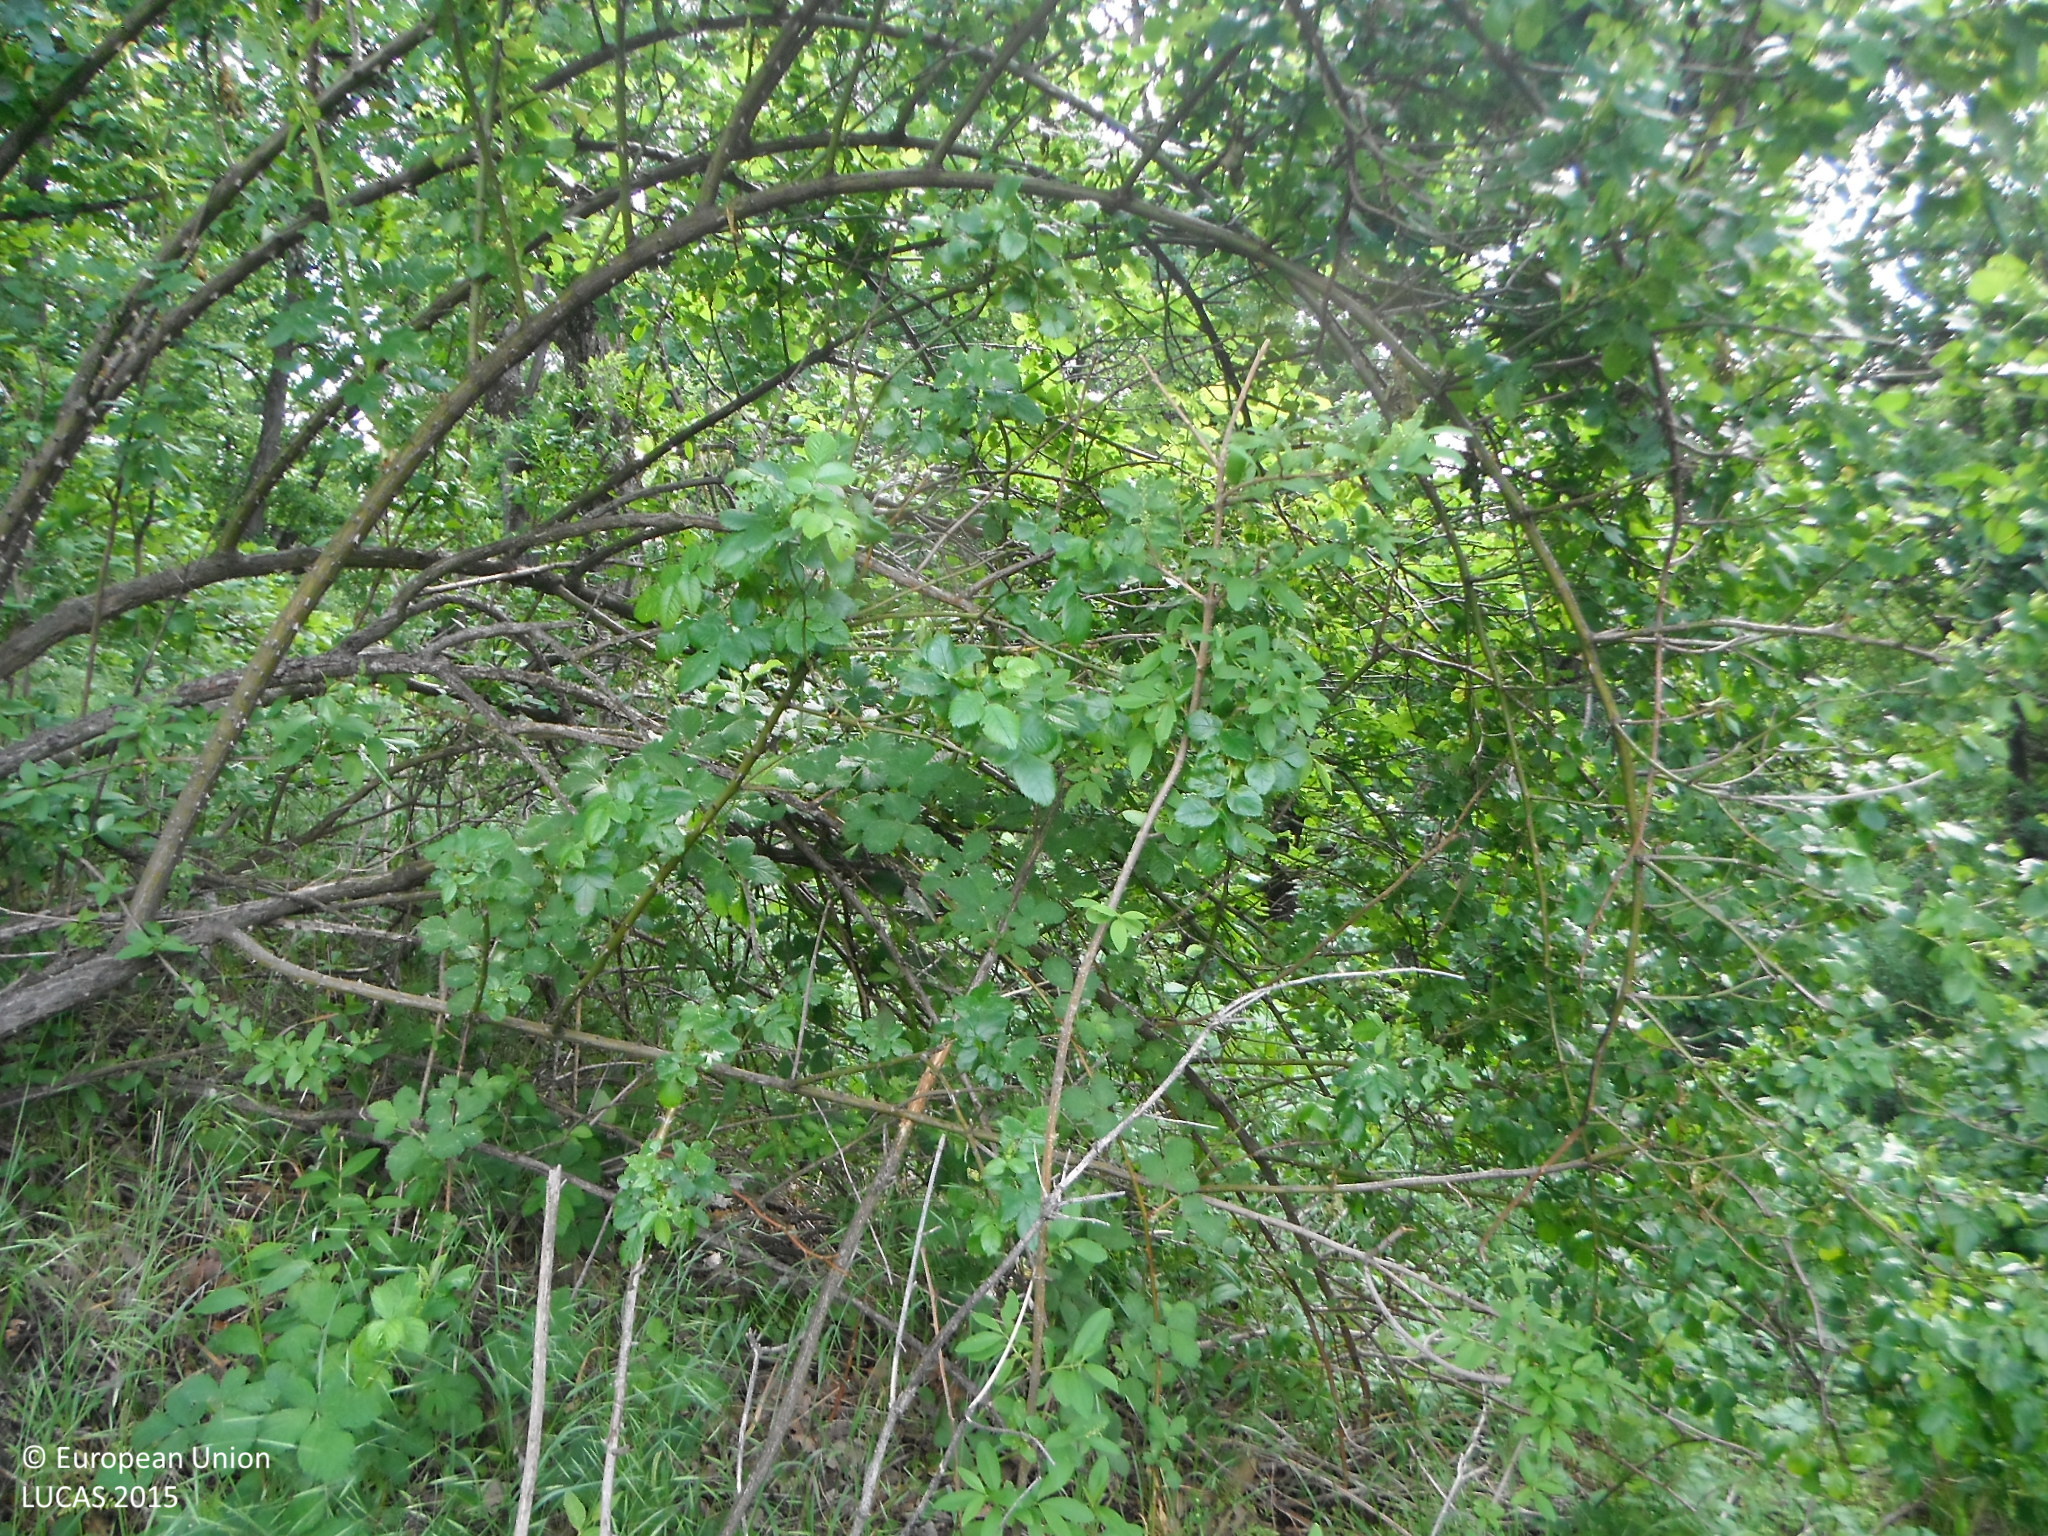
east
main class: Woodland
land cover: Broadleaved woodland
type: acidophilous oak and oak-birch forest
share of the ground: > 75 %
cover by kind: broadleaved forest trees 80 %, shrubs 10 %, herbaceous plants 10 %
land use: Forestry
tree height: > 5 m
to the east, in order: Broadleaved woodland; Tracks; Broadleaved woodland
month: May
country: SK
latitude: 48.2418
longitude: 17.1856
